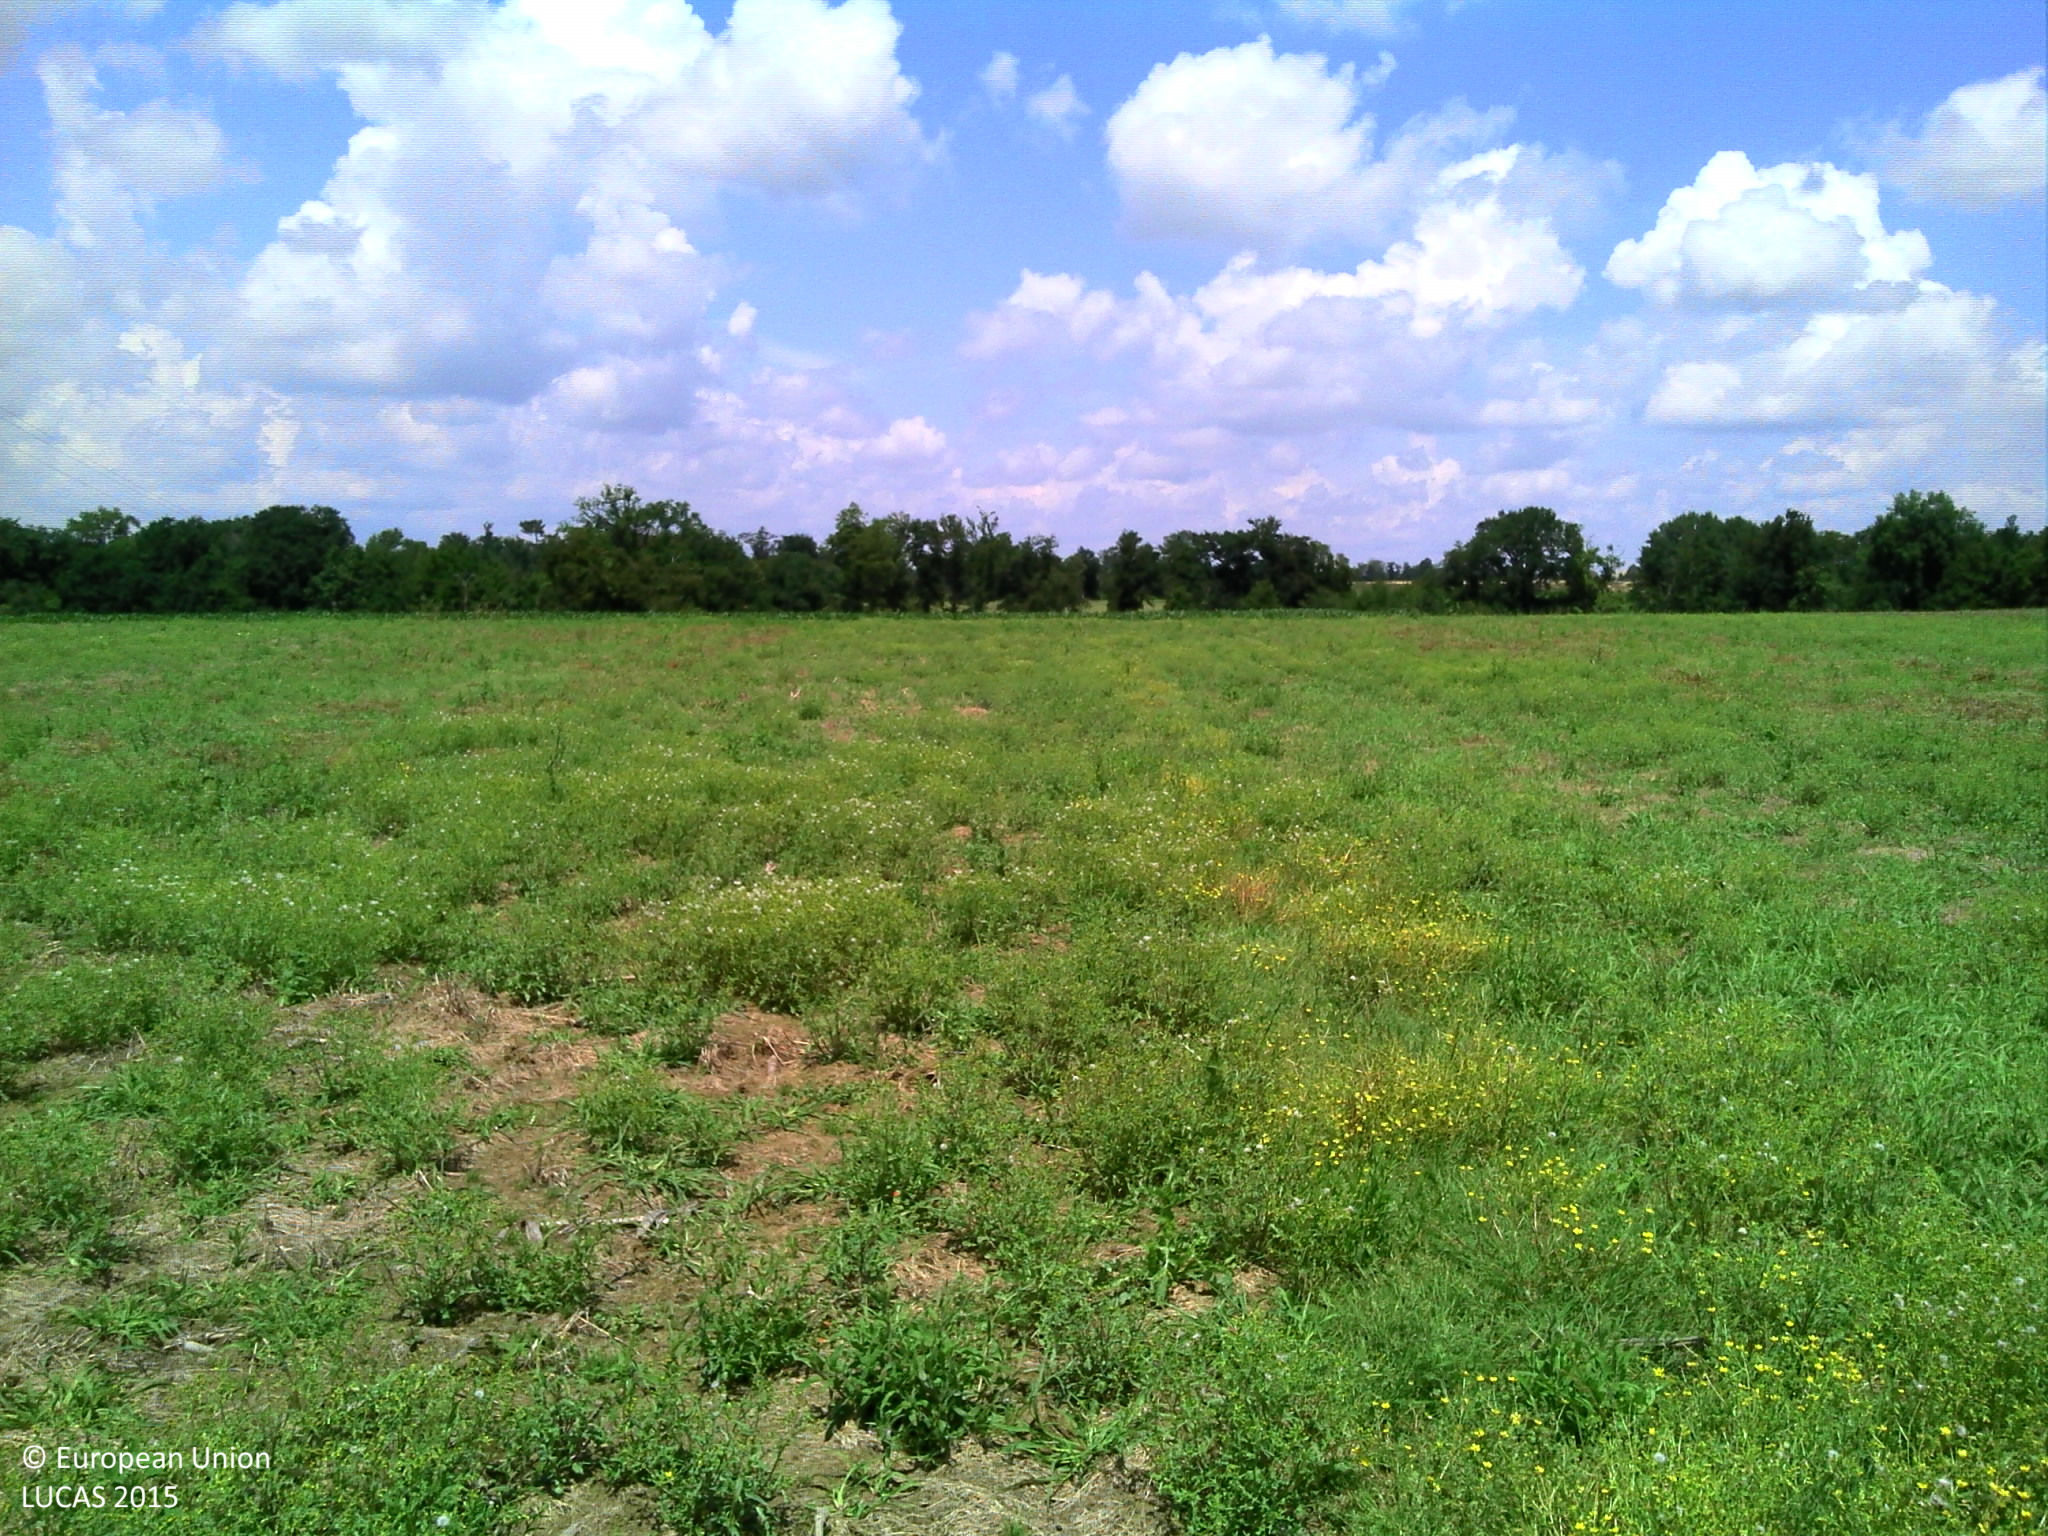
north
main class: Grassland
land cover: Spontaneously vegetated surfaces
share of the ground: > 75 %
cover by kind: herbaceous plants 75 %, unconsolidated bare surface 25 %
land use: Agriculture (excluding fallow land and kitchen gardens)
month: June
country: FR
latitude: 43.7350
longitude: -0.2268
